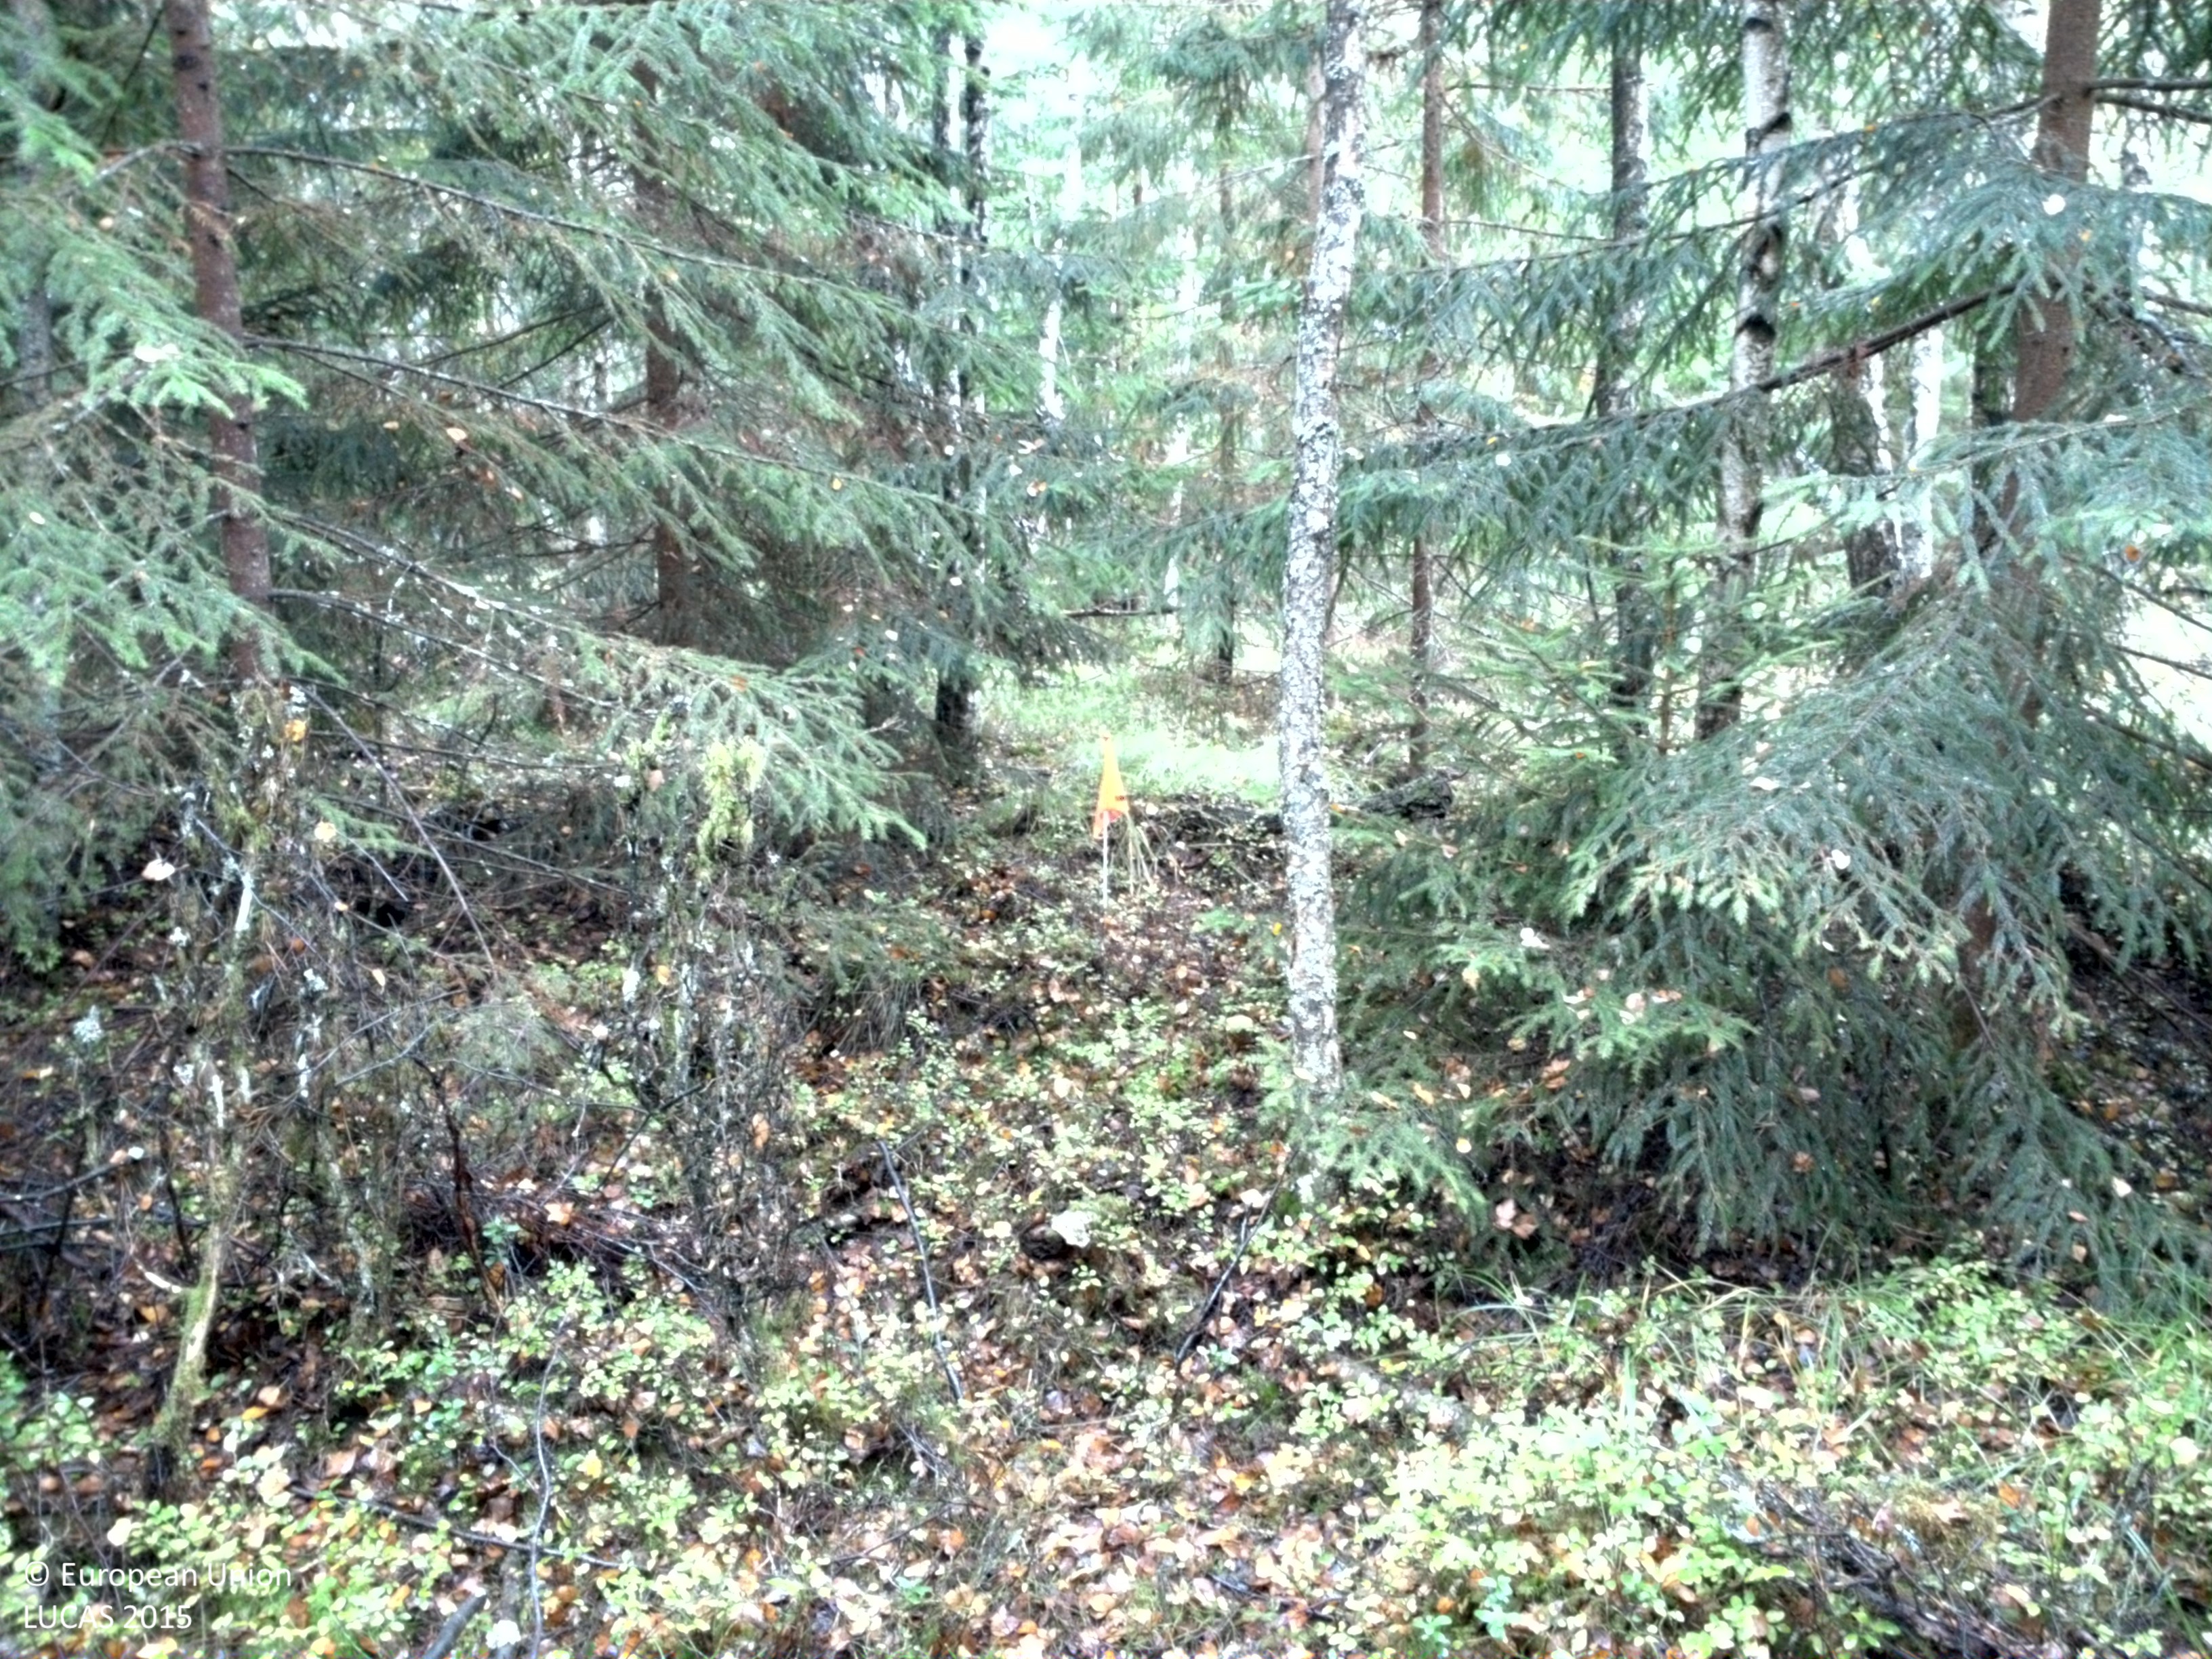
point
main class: Woodland
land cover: Spruce dominated mixed woodland
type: boreal forest
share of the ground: 50 - 75 %
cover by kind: coniferous forest trees 35 %, broadleaved forest trees 25 %, shrubs 20 %, lichens and mosses 15 %, herbaceous plants 5 %
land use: Forestry
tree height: > 5 m
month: September
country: SE
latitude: 58.1477
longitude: 13.1038
